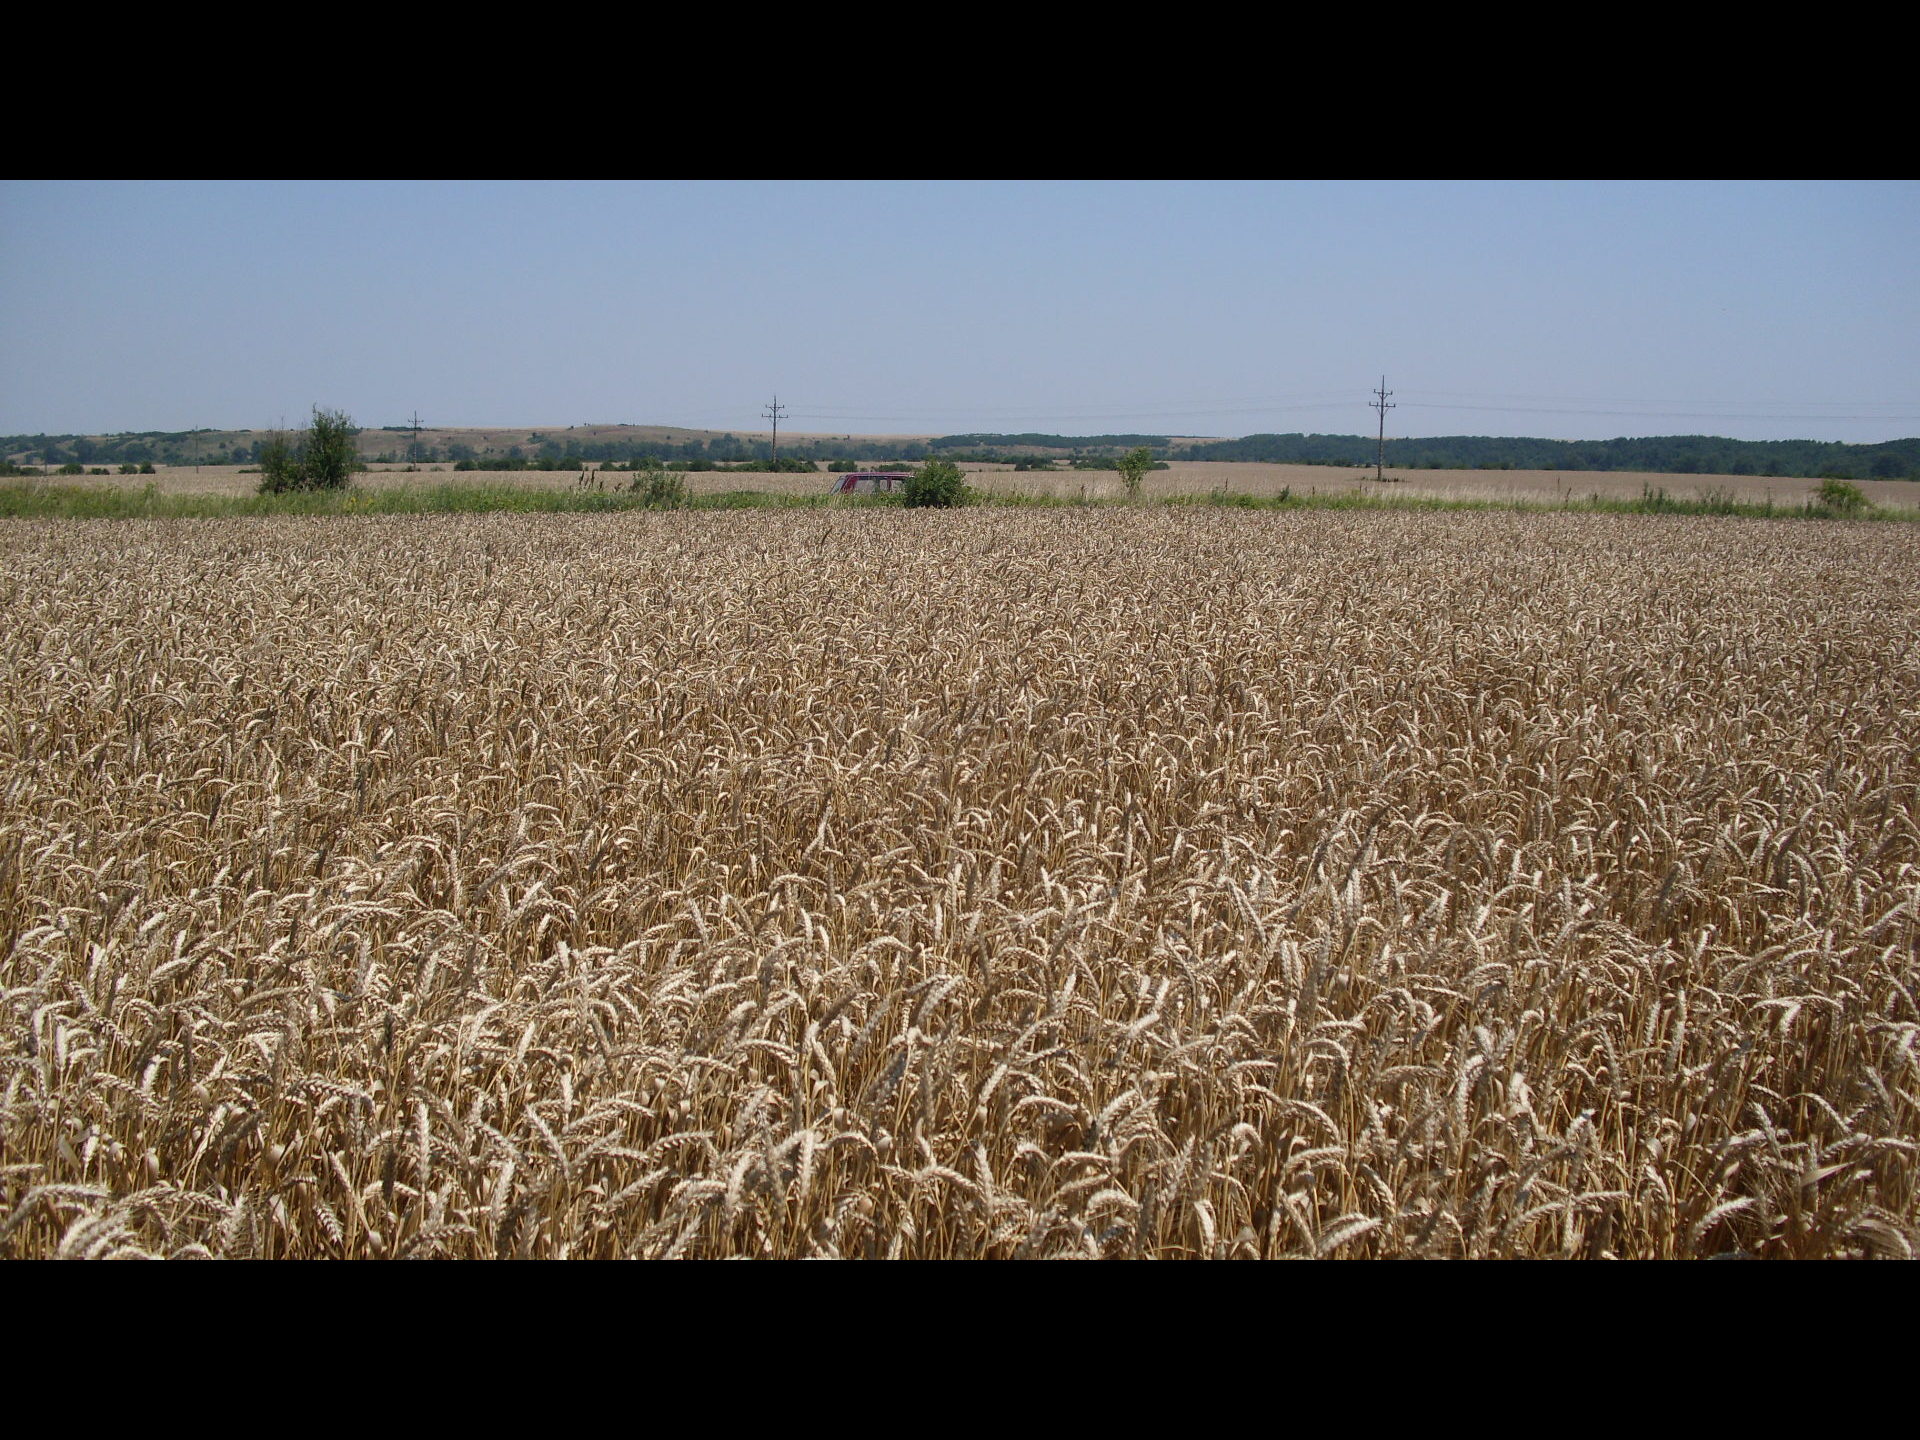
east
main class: Cropland
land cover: Common wheat
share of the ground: > 75 %
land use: Agriculture (excluding fallow land and kitchen gardens)
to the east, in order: Common wheat; Grass margins; Ditches and canals; Grass margins; Tracks; Grass margins; Common wheat
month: June
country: BG
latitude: 43.5870
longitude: 23.2568
